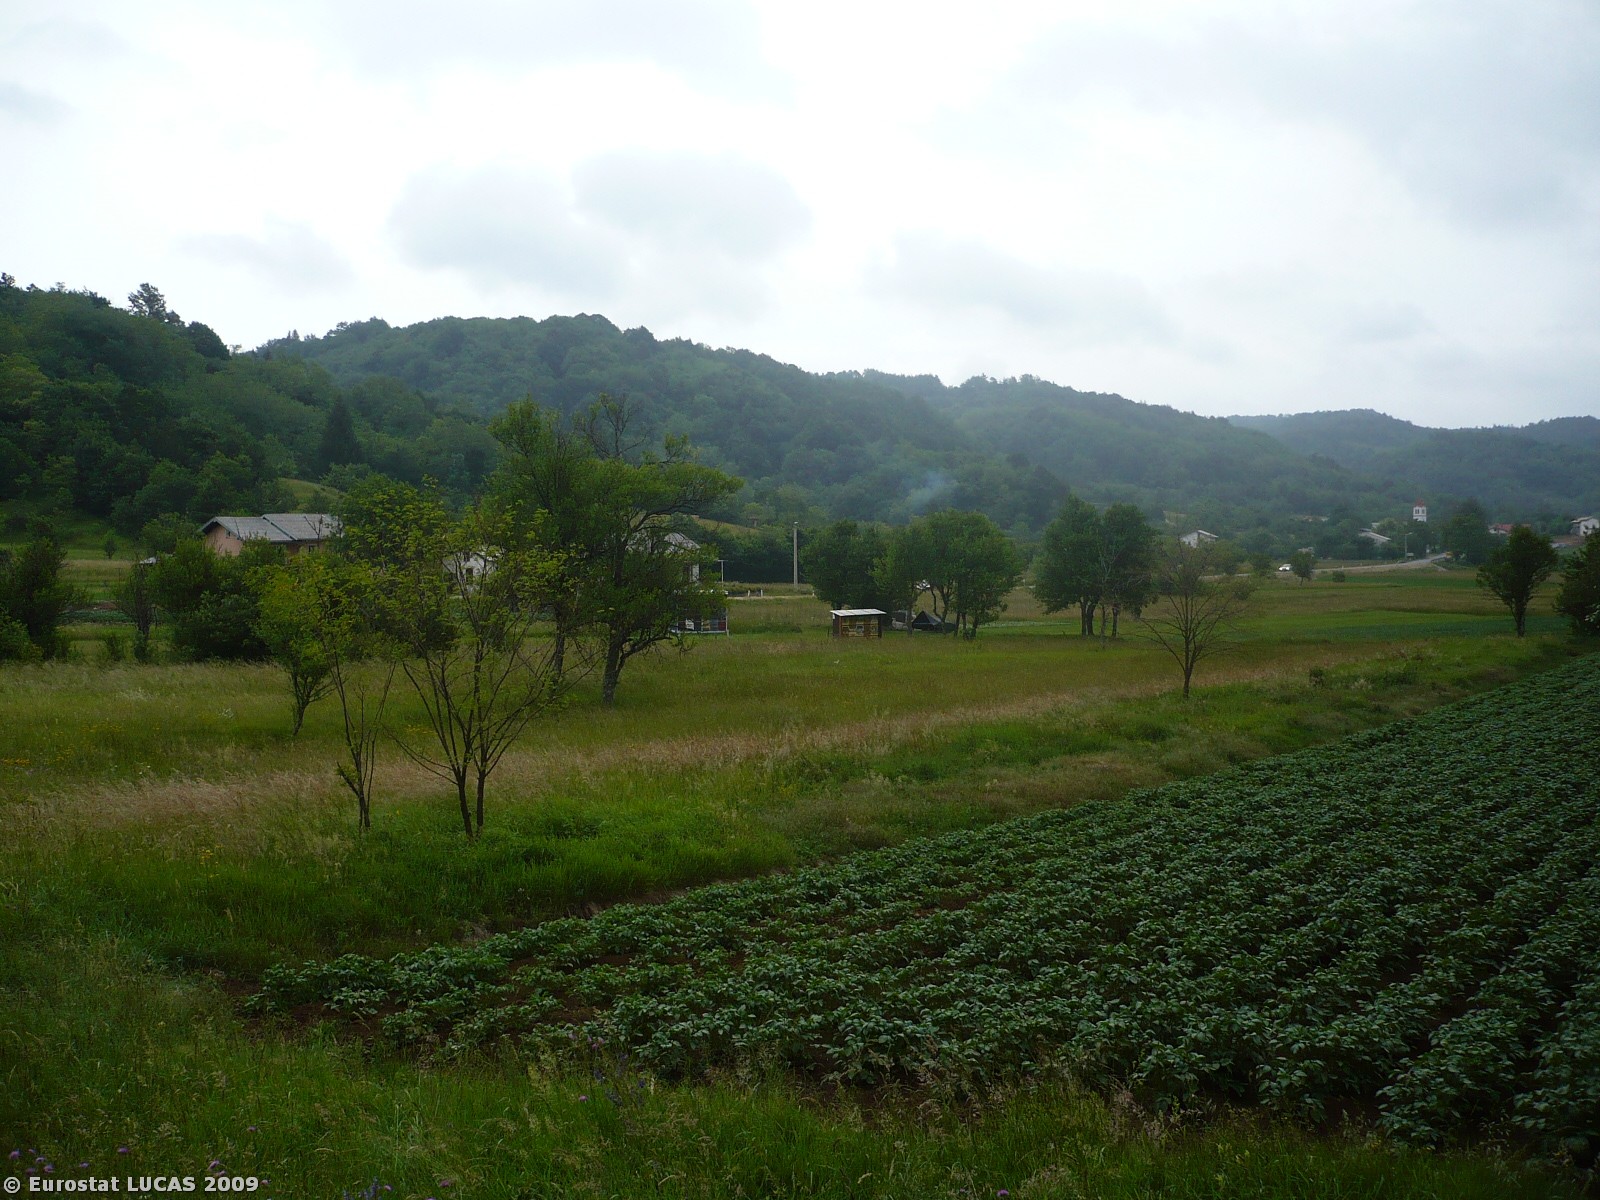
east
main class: Grassland
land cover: Grassland with sparse tree/shrub cover
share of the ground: > 75 %
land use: Agriculture (excluding fallow land and kitchen gardens)
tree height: > 5 m
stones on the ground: < 10 %
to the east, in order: Grassland with sparse tree/shrub cover; Potatoes; Grassland with sparse tree/shrub cover; Tracks; Grassland with sparse tree/shrub cover; Dry pulses; Grassland with sparse tree/shrub cover; Paved roads, cycling and walking lanes; Artificial constructions in urban areas; Grassland with sparse tree/shrub cover; Electric lines; Grassland with sparse tree/shrub cover; Temporary grasslands; Grassland with sparse tree/shrub cover; Shrubland with sparse tree cover; Grassland with sparse tree/shrub cover
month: June
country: SI
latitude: 45.5088
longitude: 14.2576
